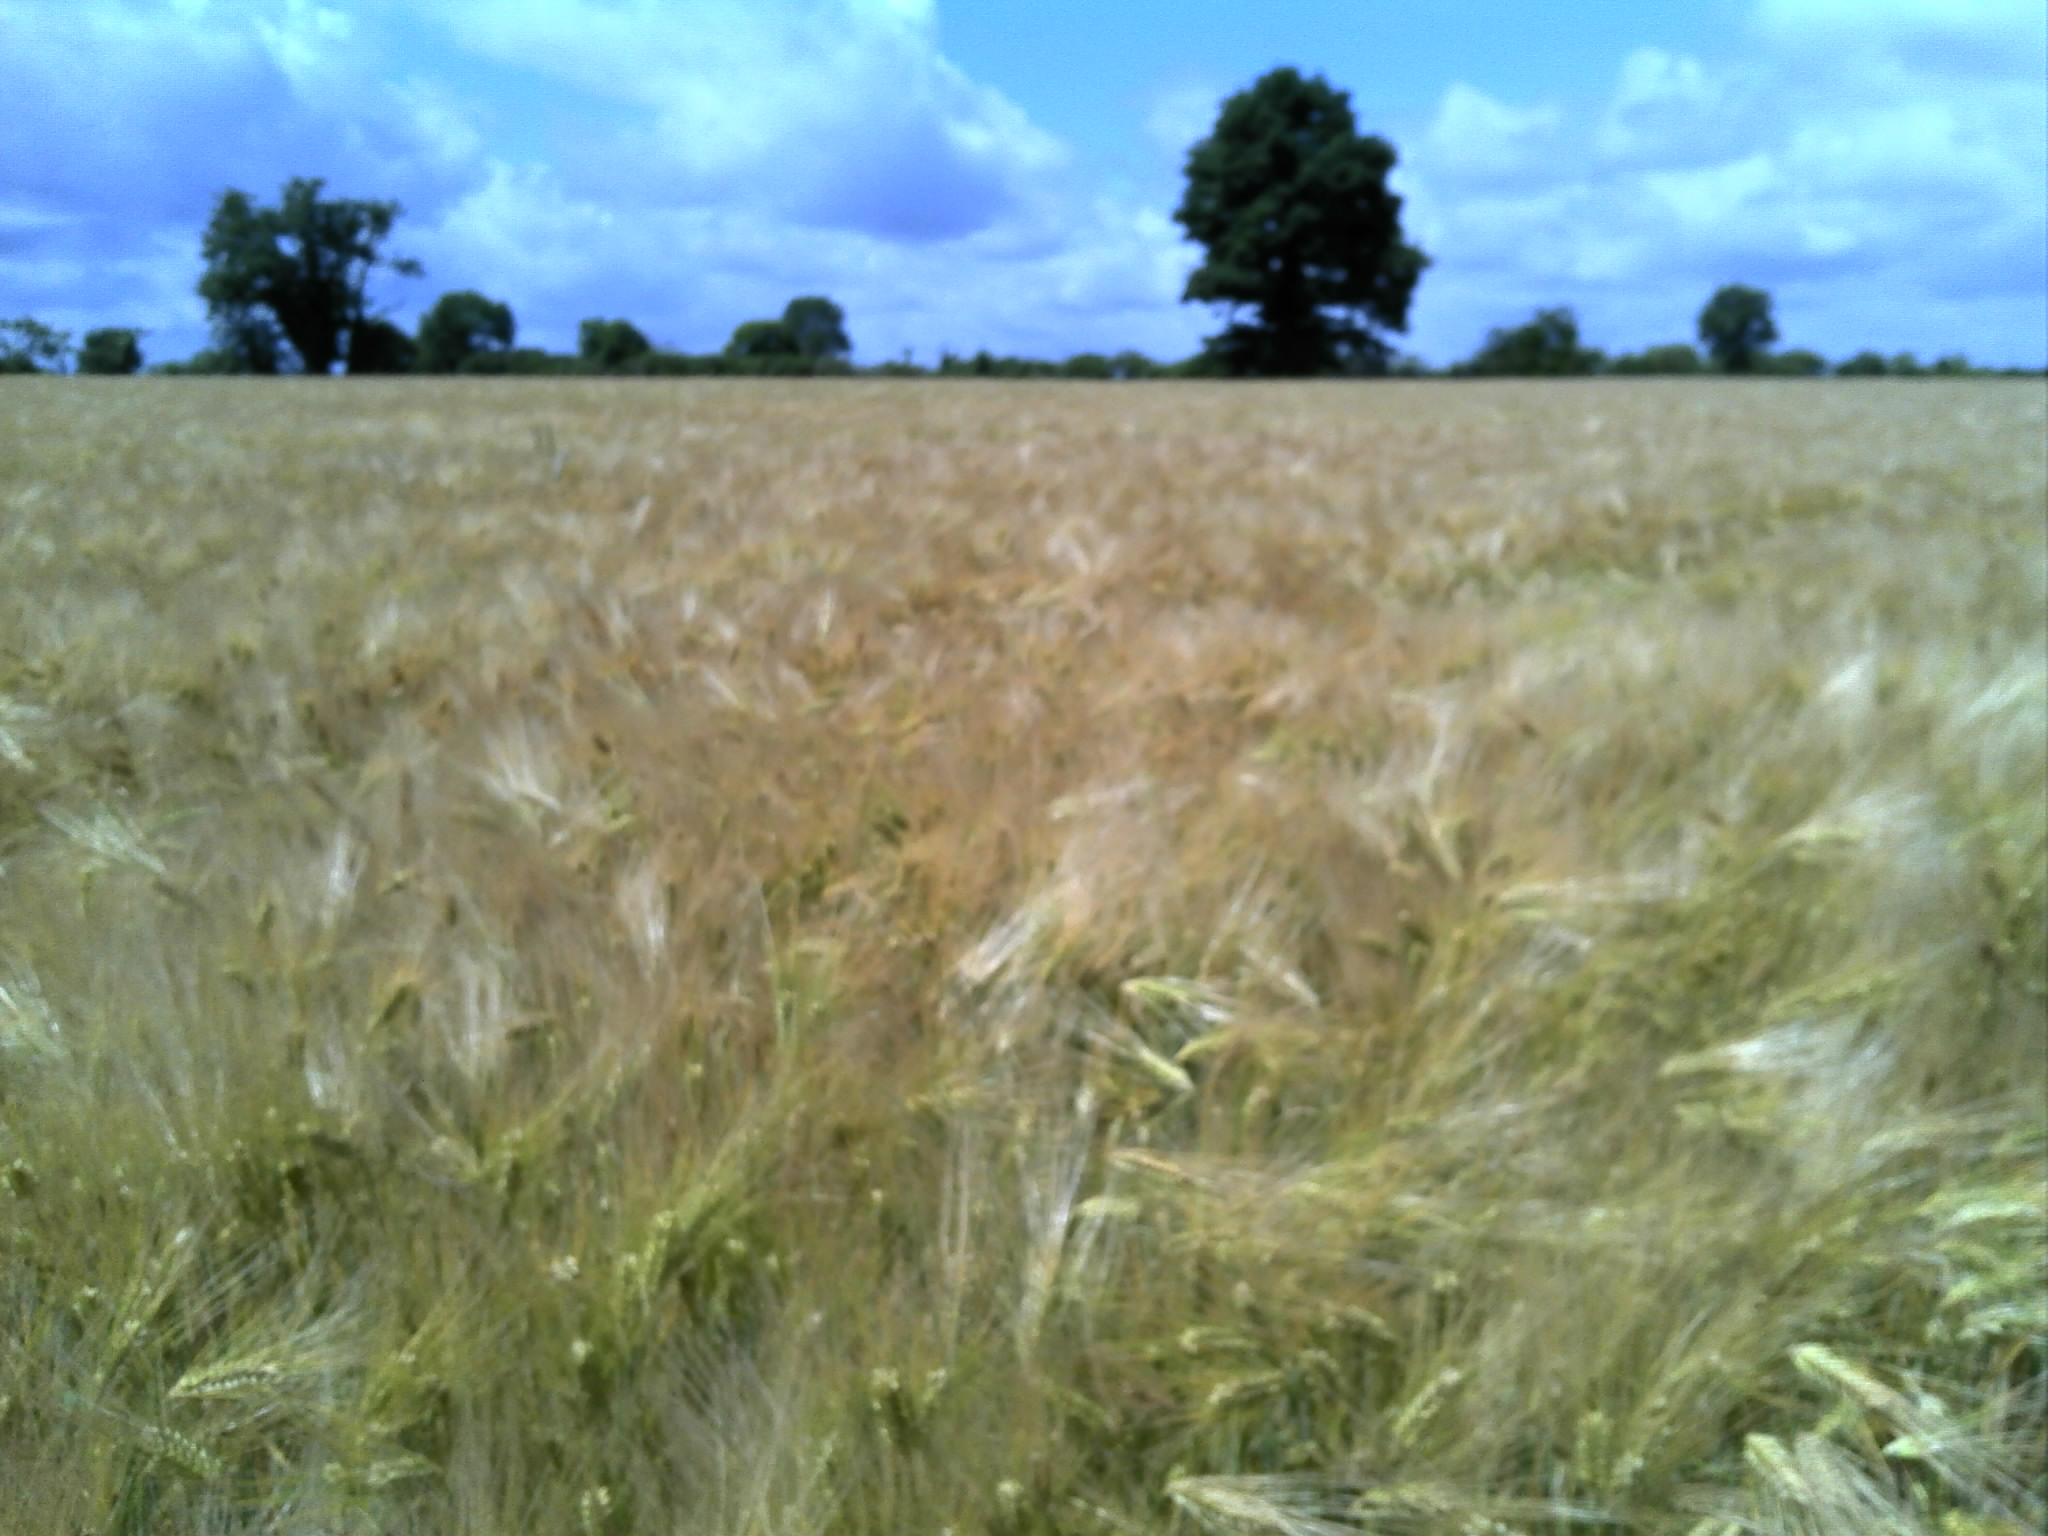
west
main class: Cropland
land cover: Barley
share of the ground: > 75 %
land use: Agriculture (excluding fallow land and kitchen gardens)
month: June
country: FR
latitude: 46.6627
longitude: 1.4809
